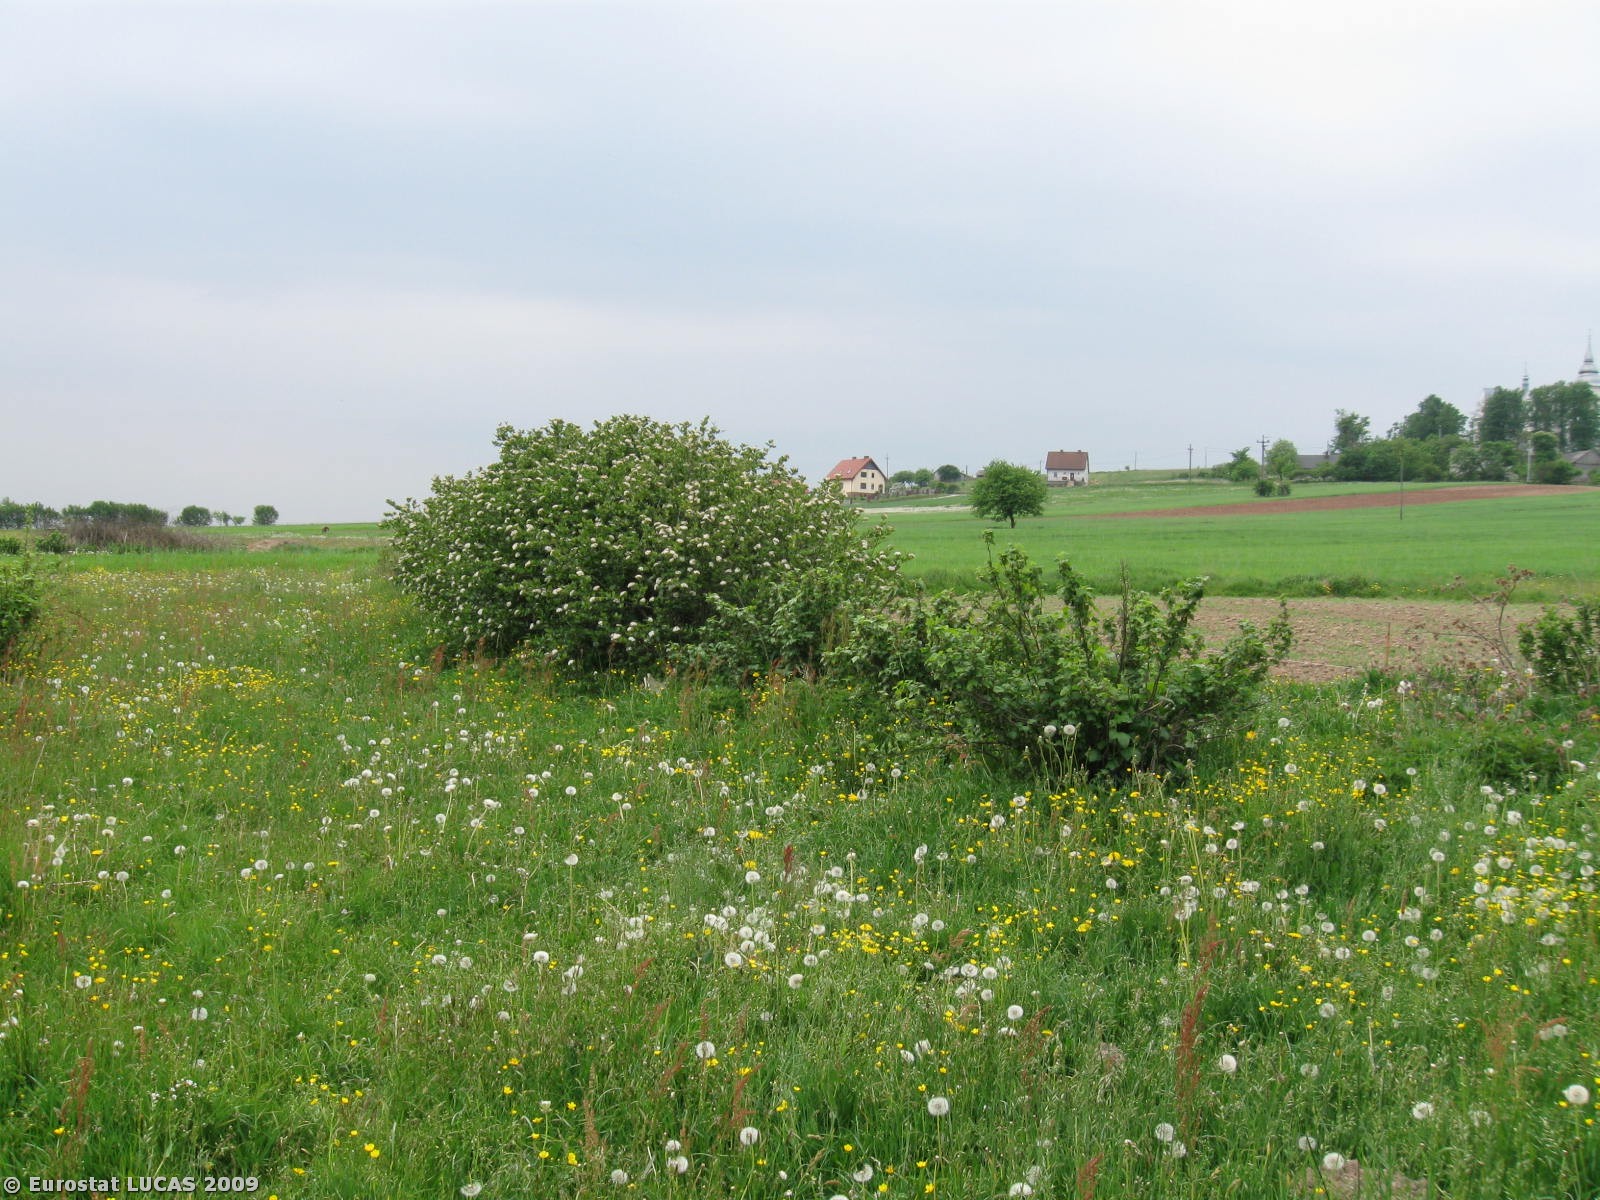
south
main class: Grassland
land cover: Grassland without tree/shrub cover
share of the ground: > 75 %
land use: Agriculture (excluding fallow land and kitchen gardens)
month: May
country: PL
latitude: 50.9316
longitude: 20.4963
